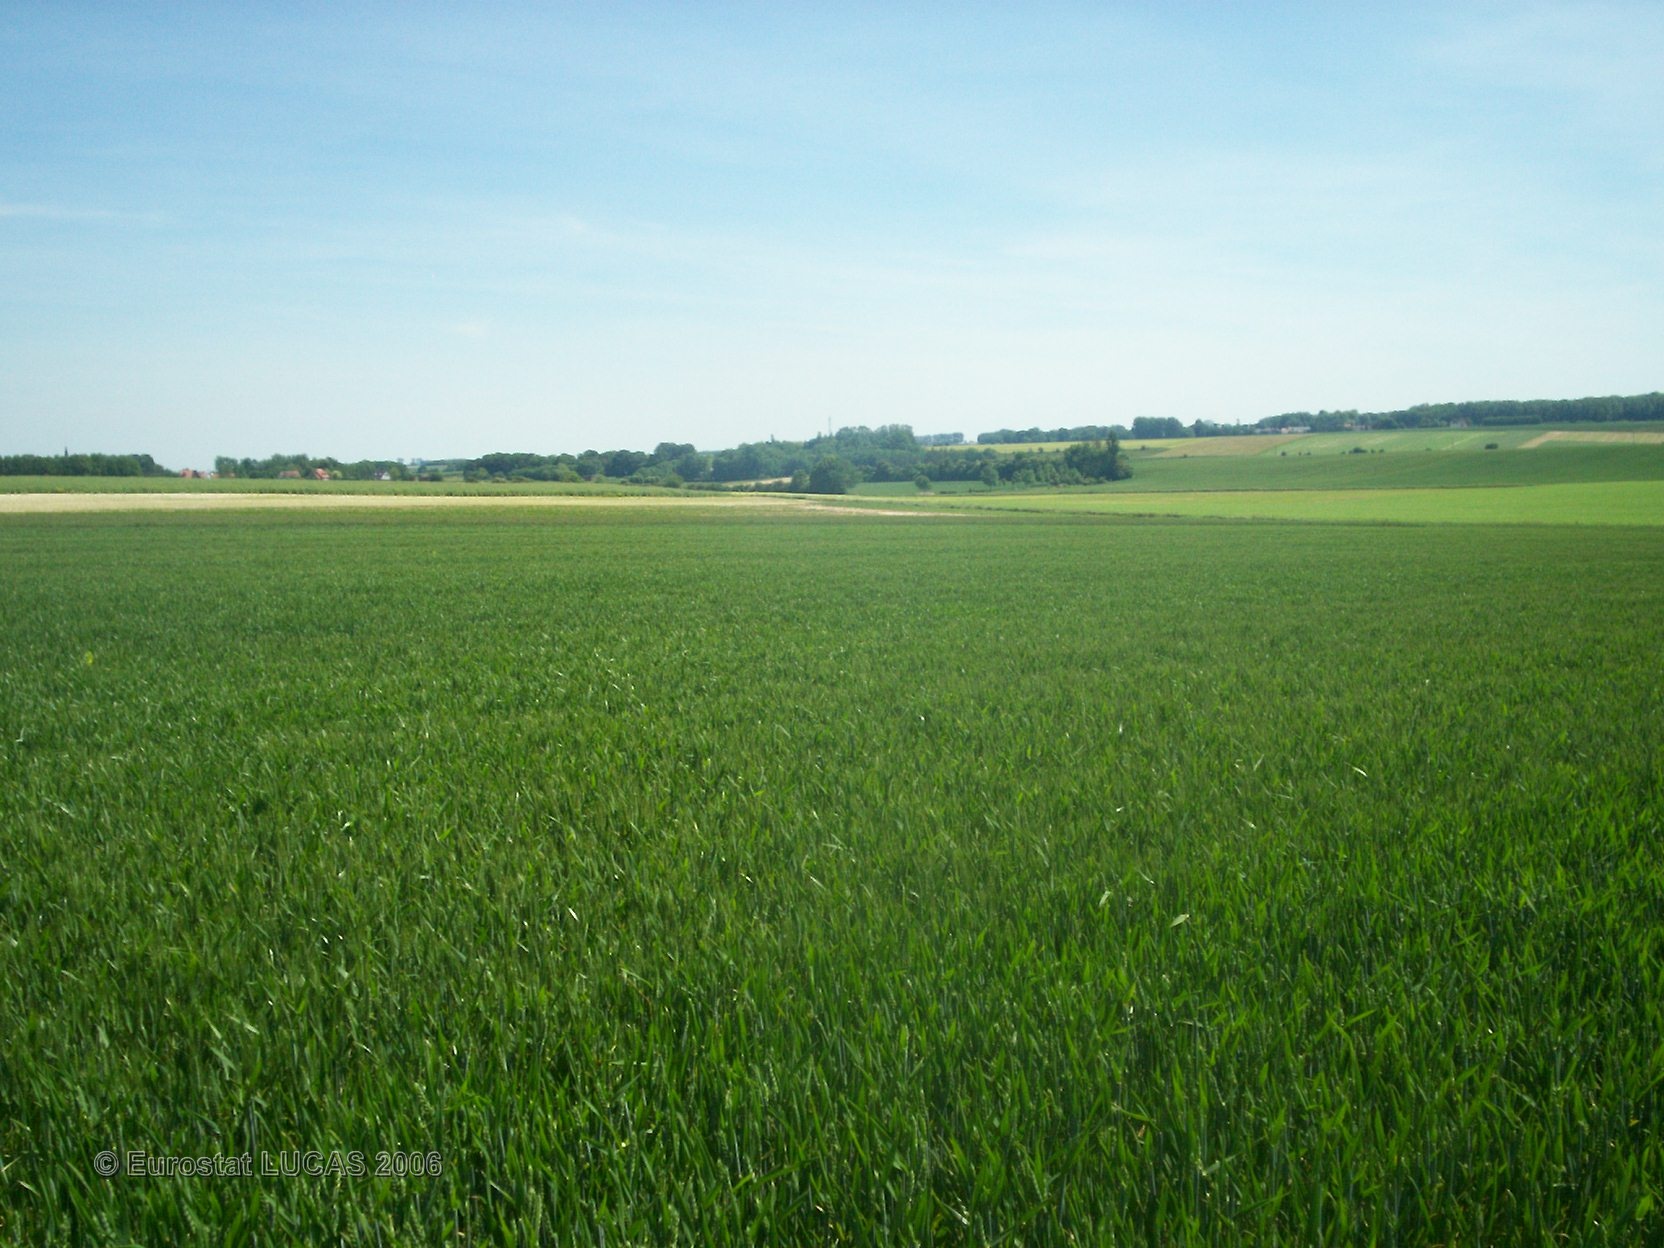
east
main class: Cropland
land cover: Common wheat
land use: Agriculture (excluding fallow land and kitchen gardens)
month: June
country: FR
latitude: 50.2522
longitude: 2.6251
